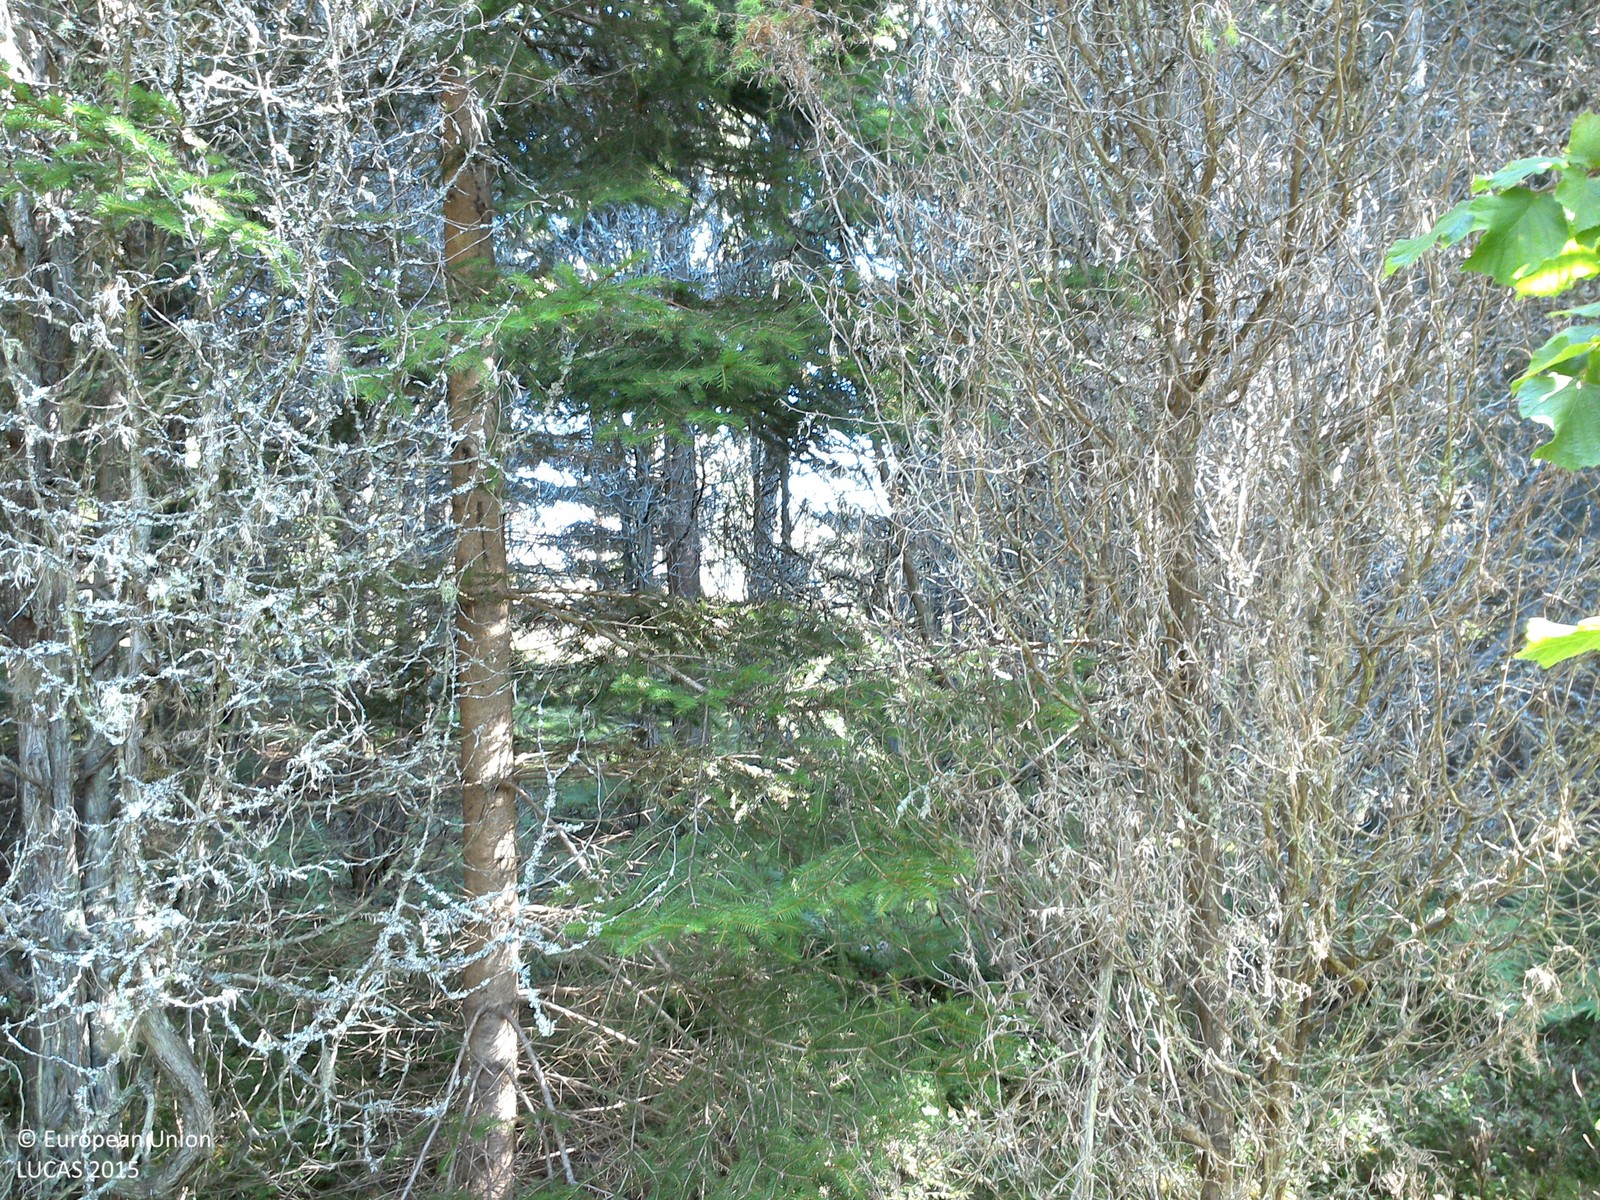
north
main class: Woodland
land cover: Spruce dominated mixed woodland
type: boreal forest
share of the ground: 50 - 75 %
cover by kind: coniferous forest trees 50 %, herbaceous plants 30 %, broadleaved forest trees 20 %
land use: Forestry
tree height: > 5 m
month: August
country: SE
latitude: 58.0906
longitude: 14.9985
